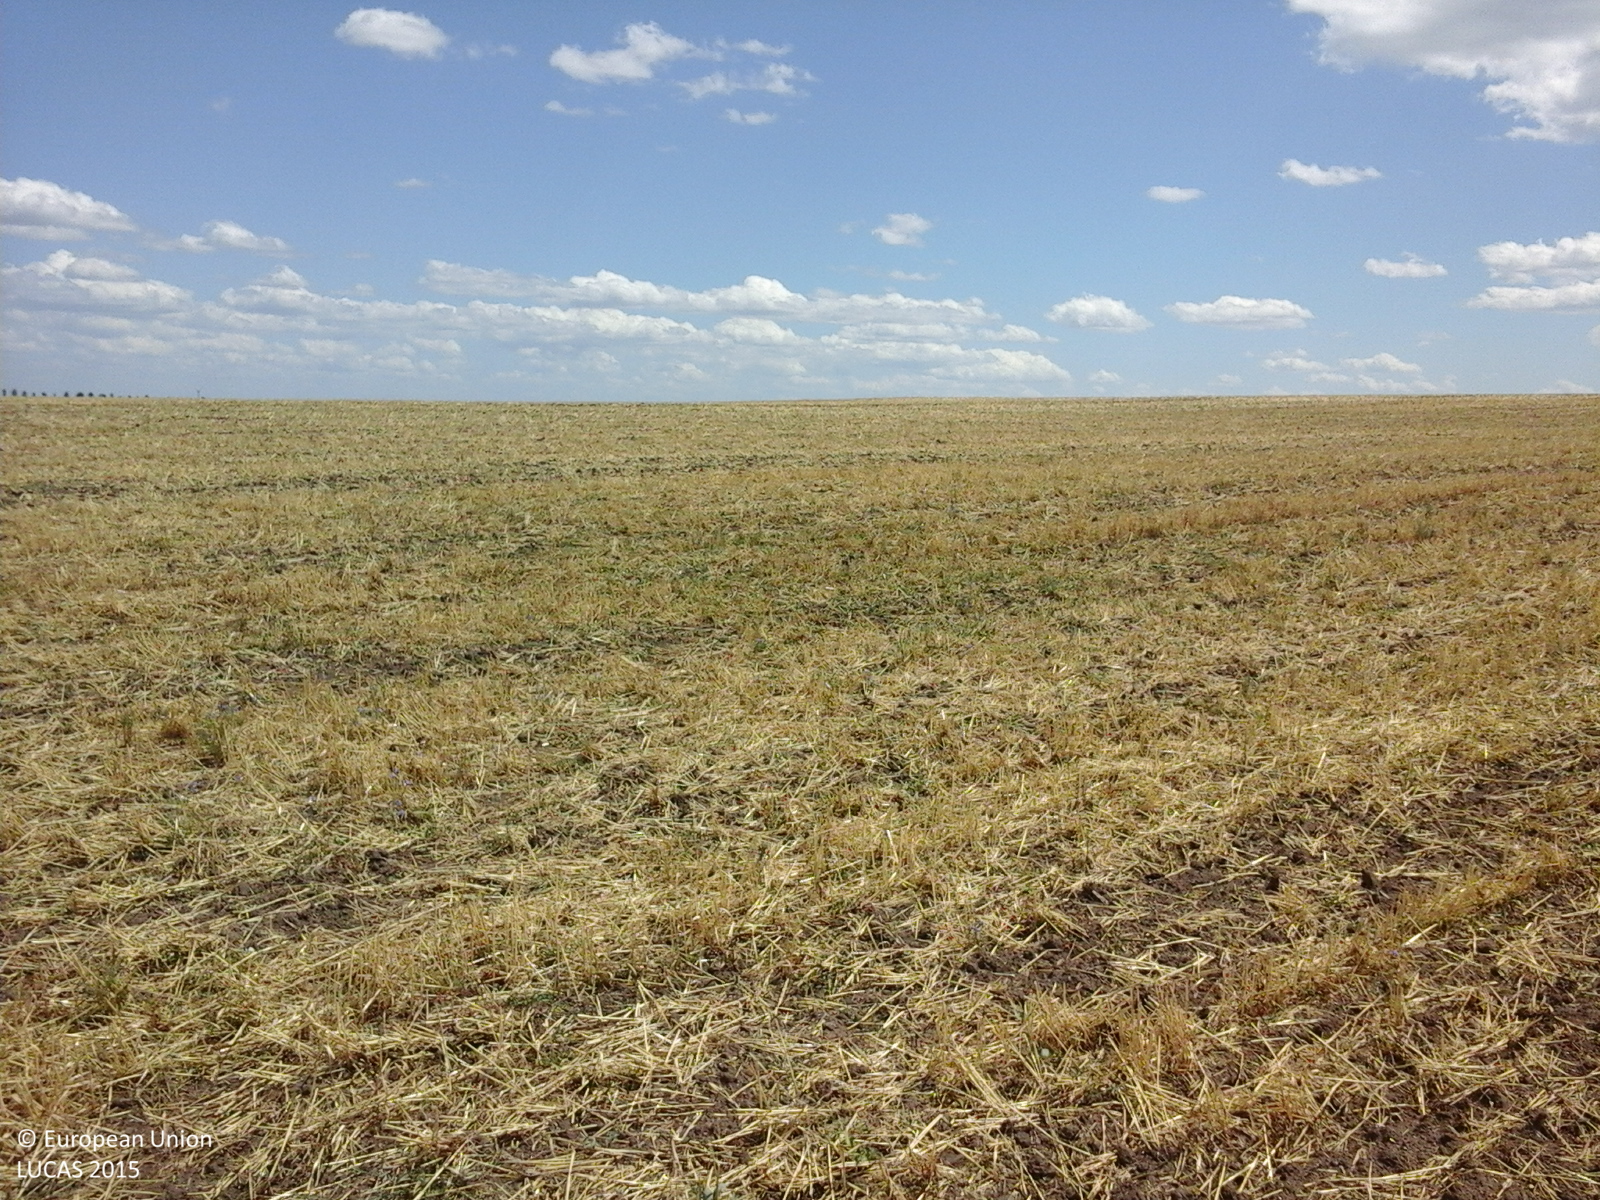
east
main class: Cropland
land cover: Common wheat
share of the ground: 25 - 50 %
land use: Agriculture (excluding fallow land and kitchen gardens)
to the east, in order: Common wheat; Other bare soil
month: July
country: RO
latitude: 45.9127
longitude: 27.6835
